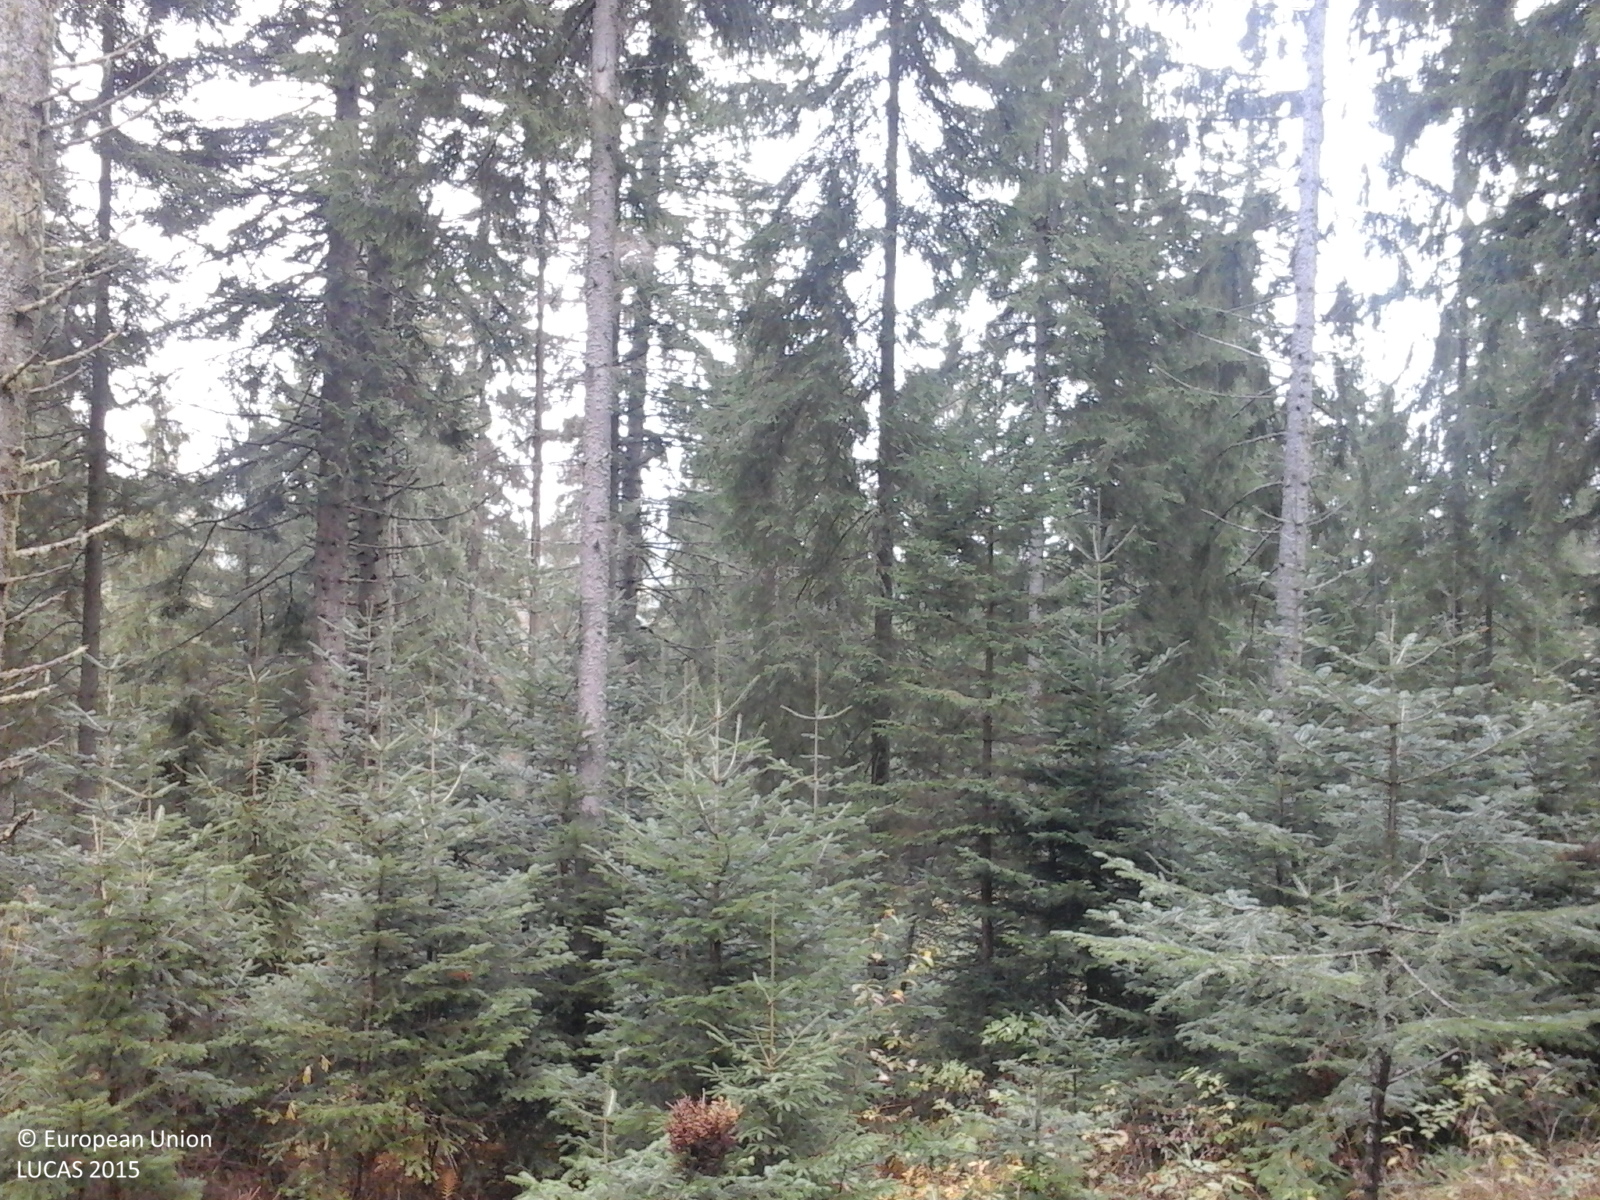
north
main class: Woodland
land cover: Other coniferous woodland
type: alpine coniferous forest
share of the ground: > 75 %
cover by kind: coniferous forest trees 75 %, broadleaved forest trees 10 %, herbaceous plants 10 %, shrubs 5 %
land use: Forestry
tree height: > 5 m
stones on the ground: < 10 %
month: October
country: RO
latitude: 46.8319
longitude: 25.3281
